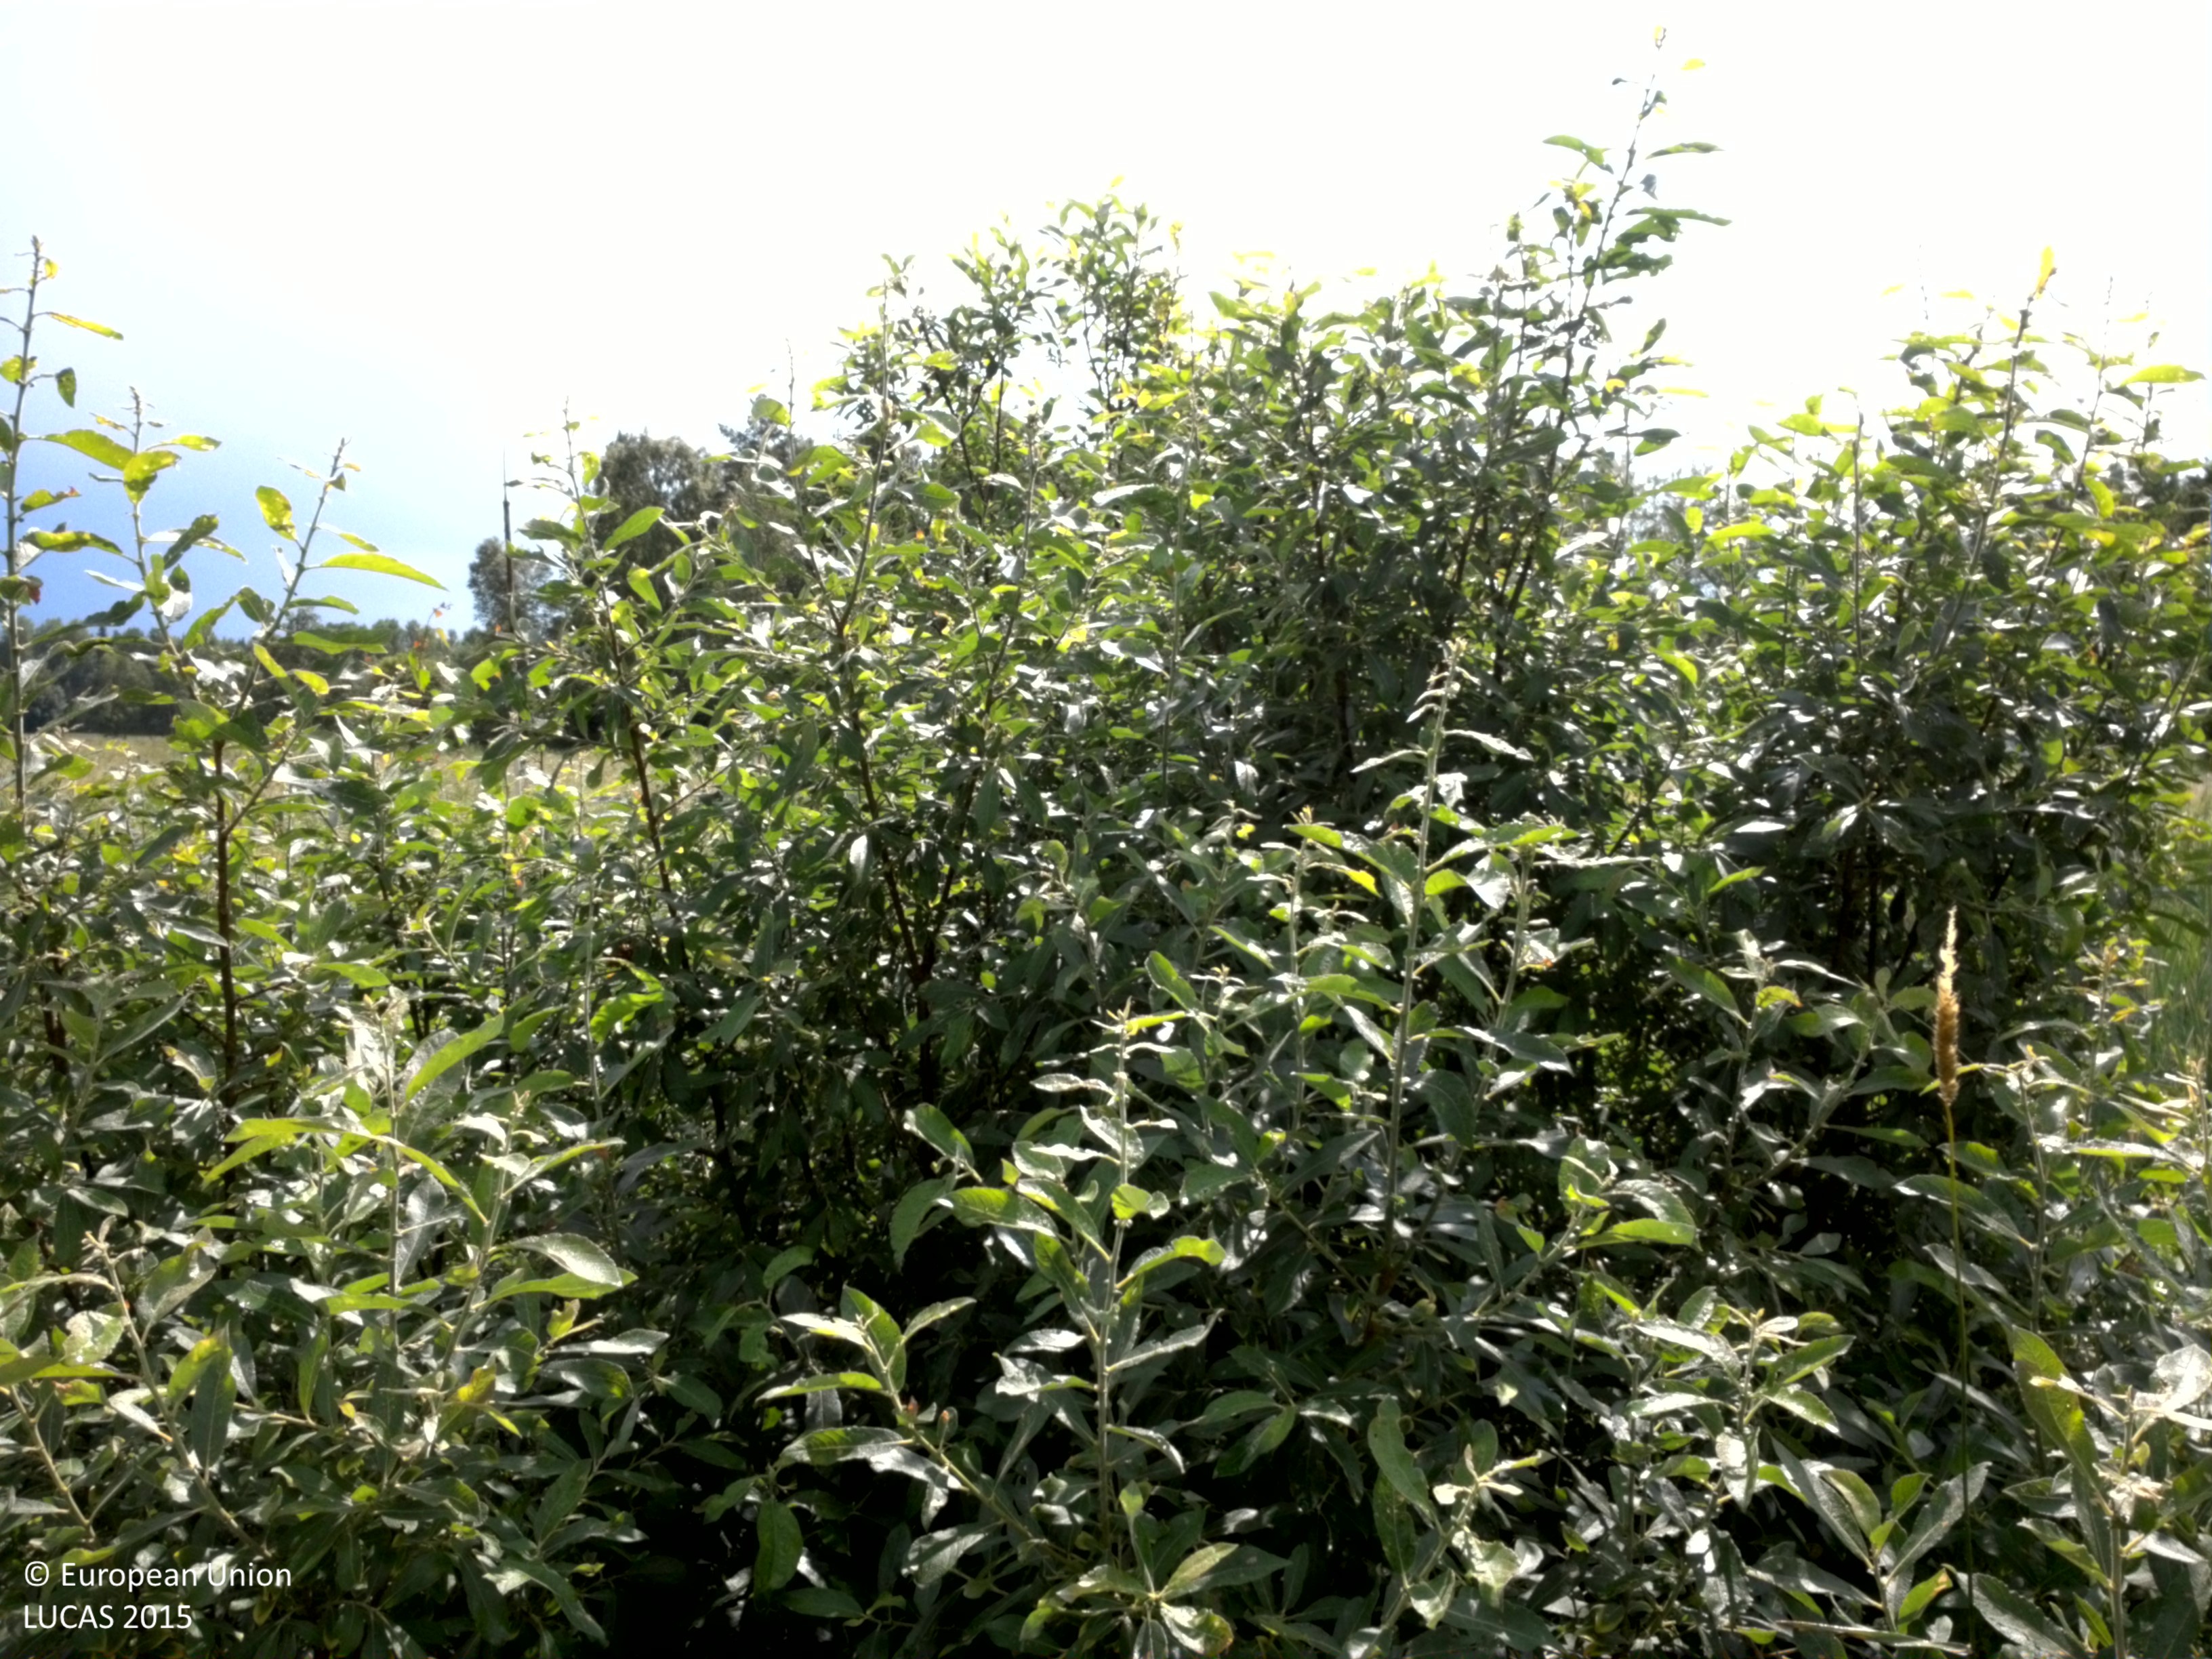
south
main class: Grassland
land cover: Grassland without tree/shrub cover
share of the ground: > 75 %
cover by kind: herbaceous plants 100 %
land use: Agriculture (excluding fallow land and kitchen gardens)
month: July
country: SE
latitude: 59.9534
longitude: 18.6108
